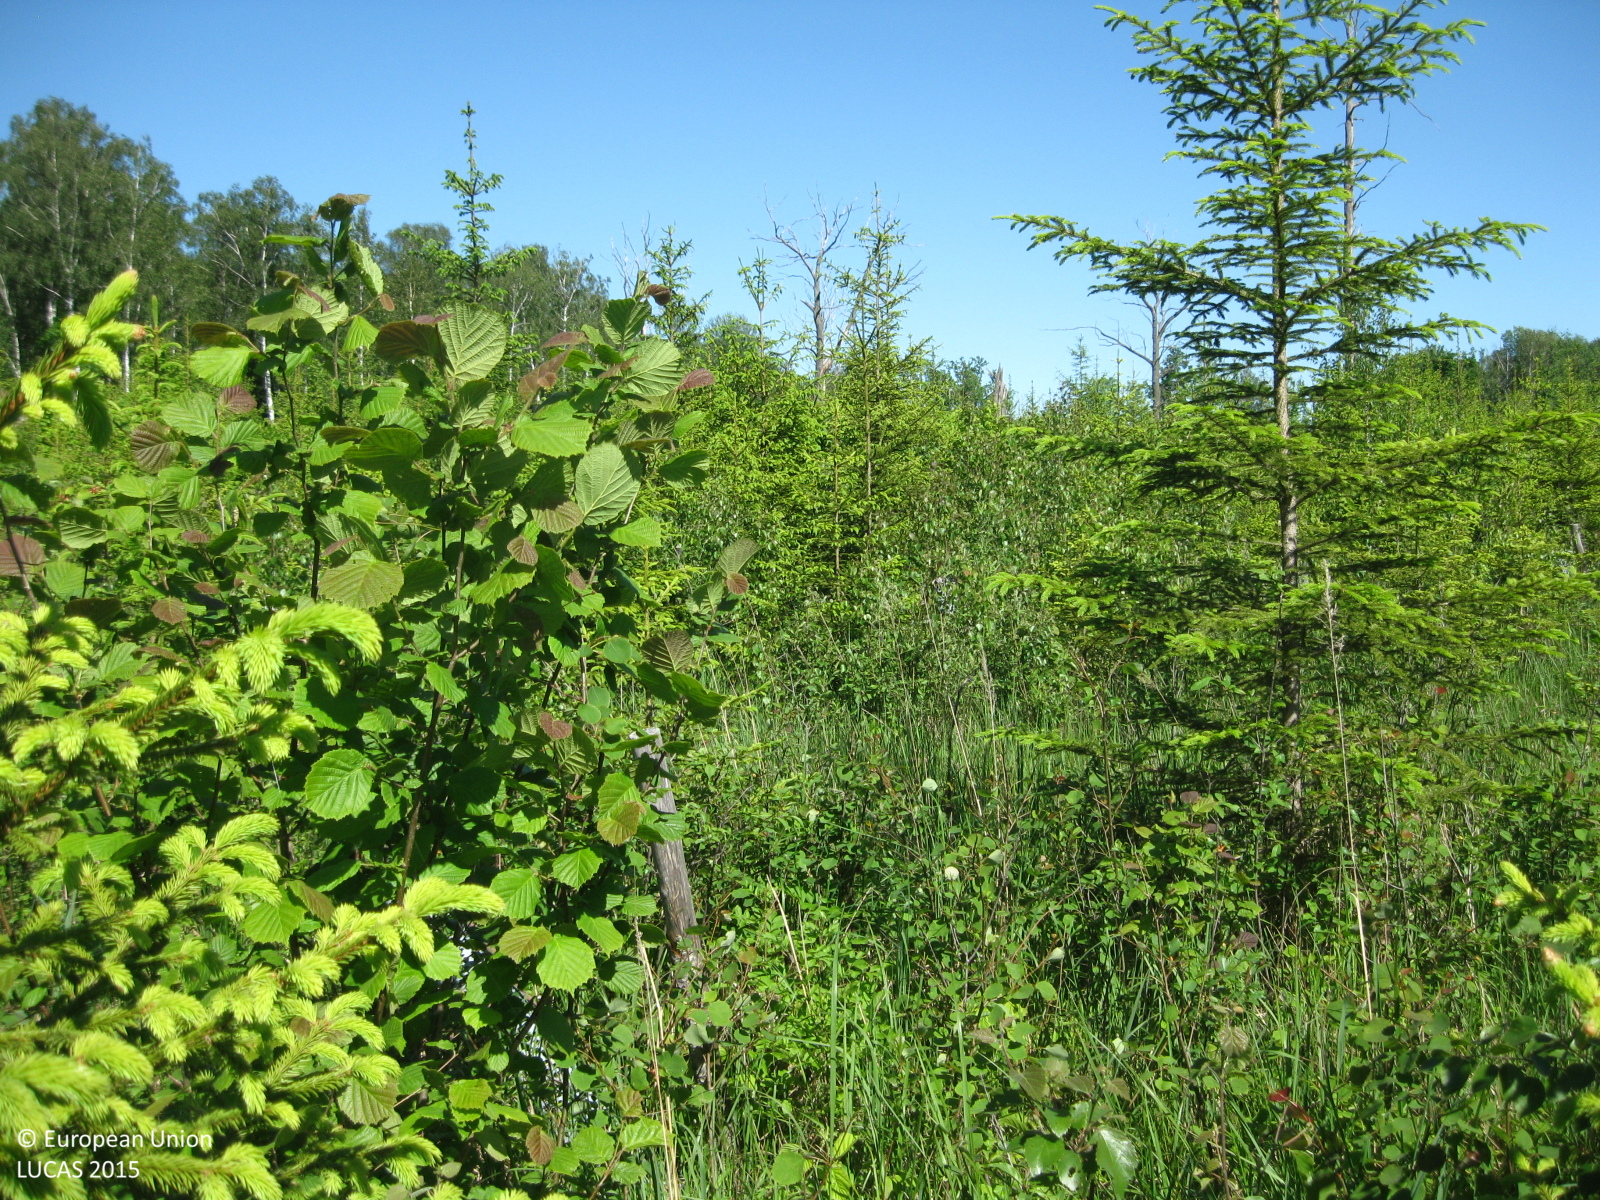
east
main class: Woodland
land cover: Spruce dominated mixed woodland
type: hemiboreal forest and nemoral coniferous forest and mixed broadleaved-coniferous forest
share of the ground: 50 - 75 %
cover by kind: coniferous forest trees 35 %, broadleaved forest trees 35 %, herbaceous plants 20 %, shrubs 10 %
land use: Forestry
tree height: < 5 m
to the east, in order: Spruce dominated mixed woodland; Broadleaved woodland
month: June
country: LT
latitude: 55.6638
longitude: 24.0632
